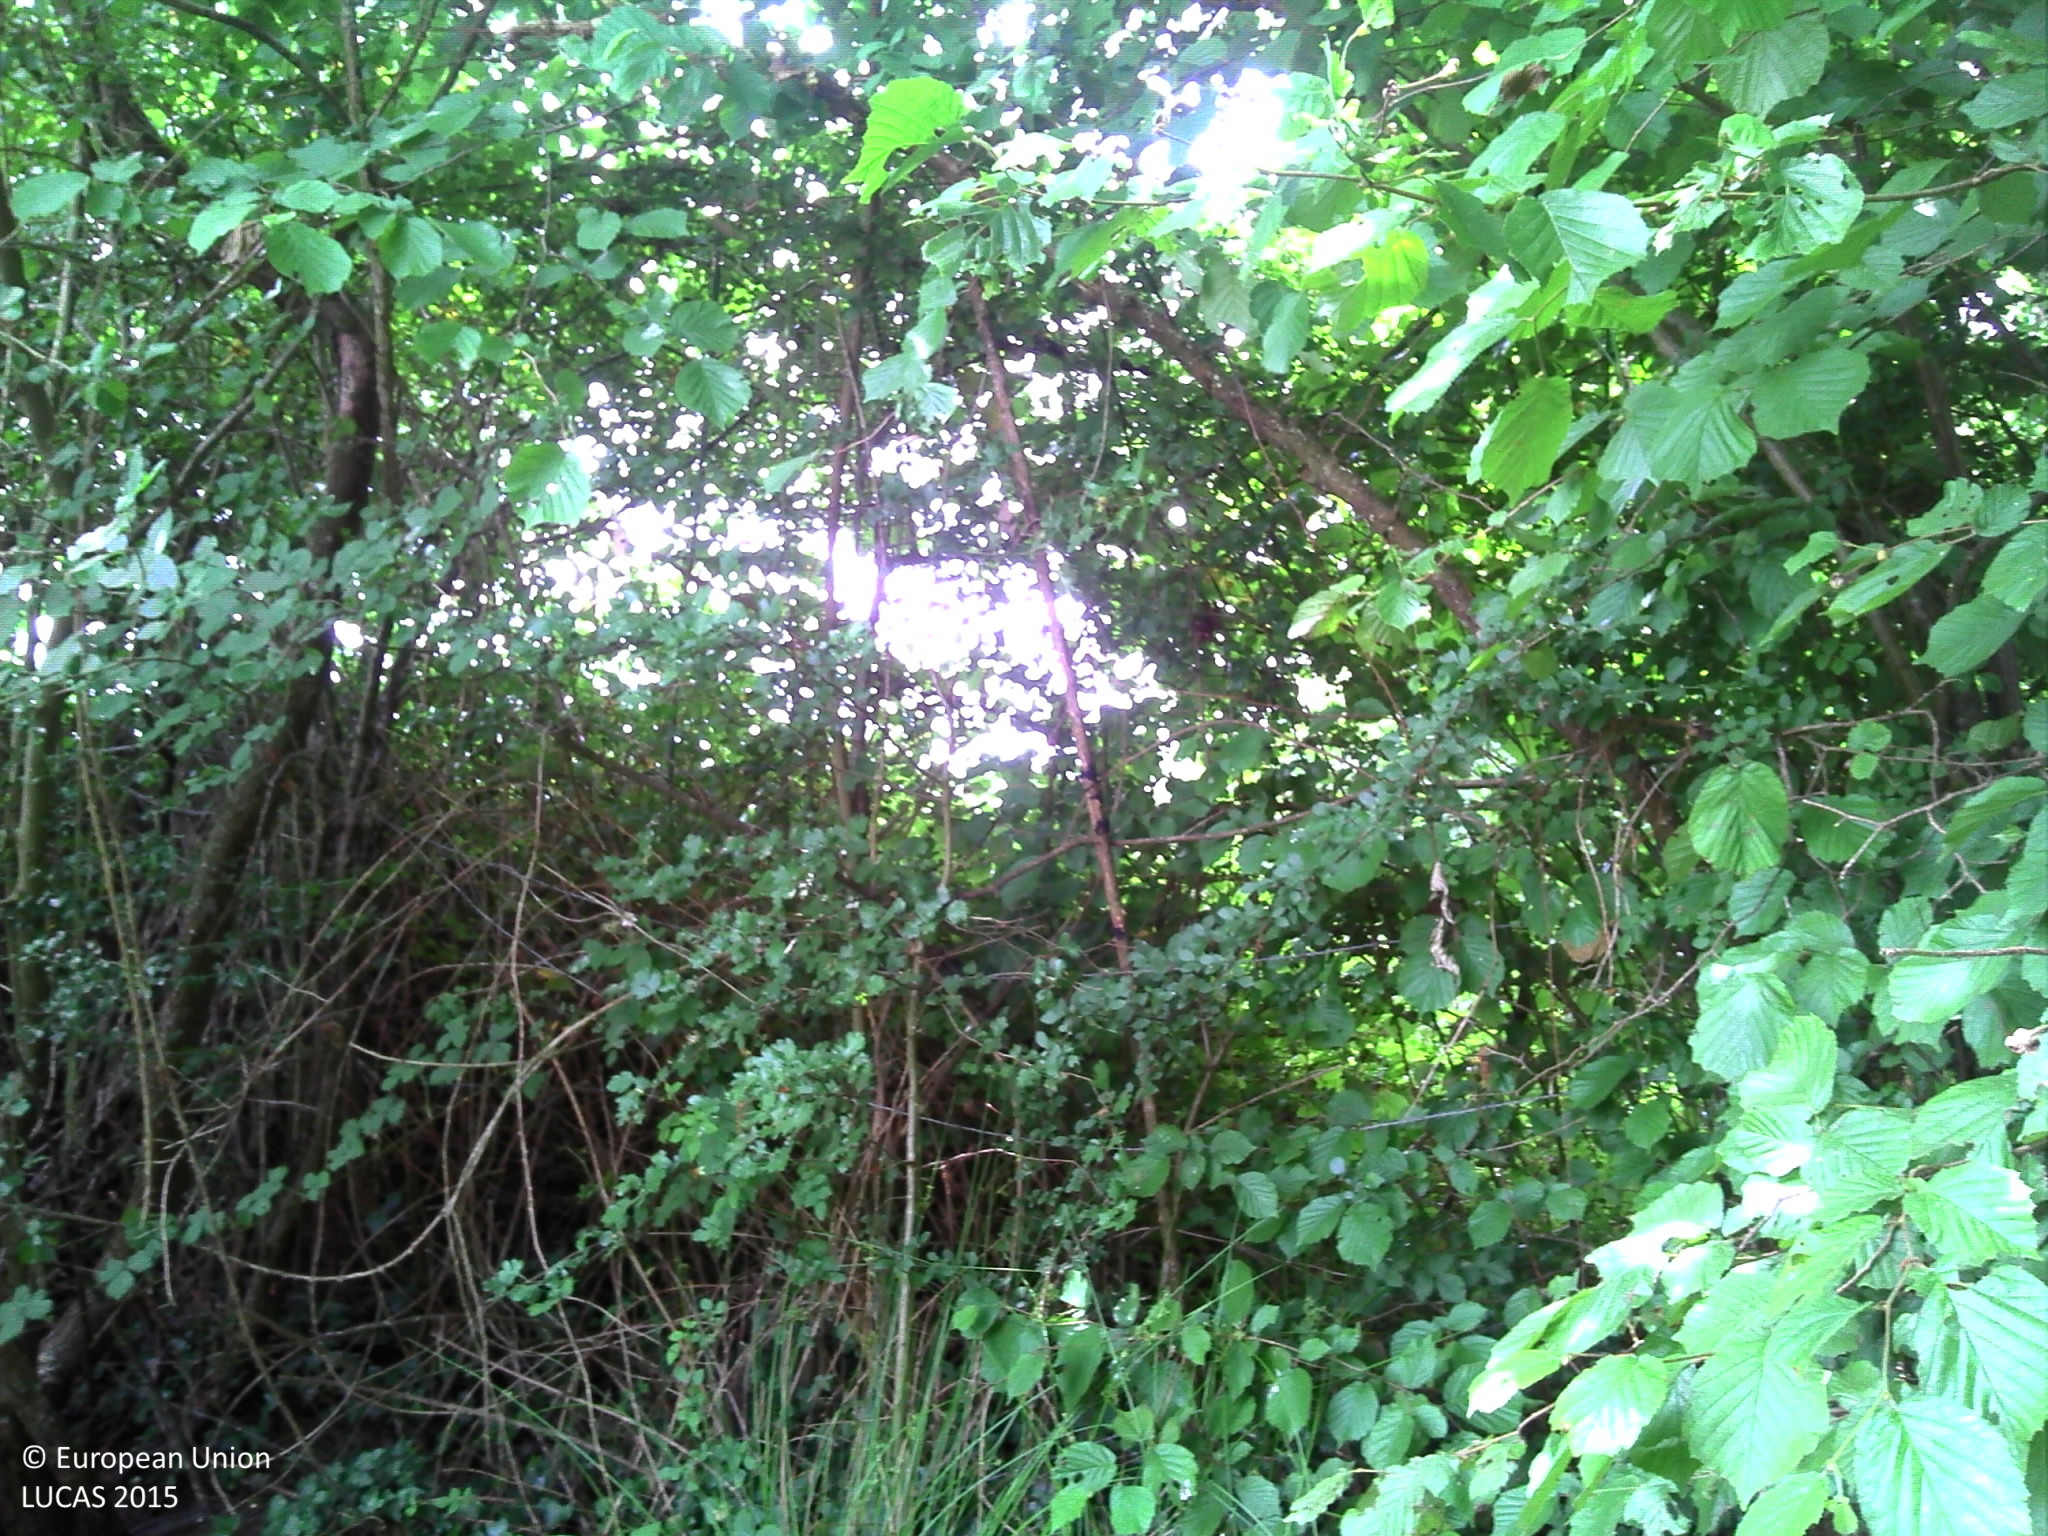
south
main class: Woodland
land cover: Broadleaved woodland
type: beech forest
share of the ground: > 75 %
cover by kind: broadleaved forest trees 75 %, herbaceous plants 15 %, shrubs 10 %
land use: Forestry
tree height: > 5 m
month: June
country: FR
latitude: 48.4383
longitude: 0.1995
